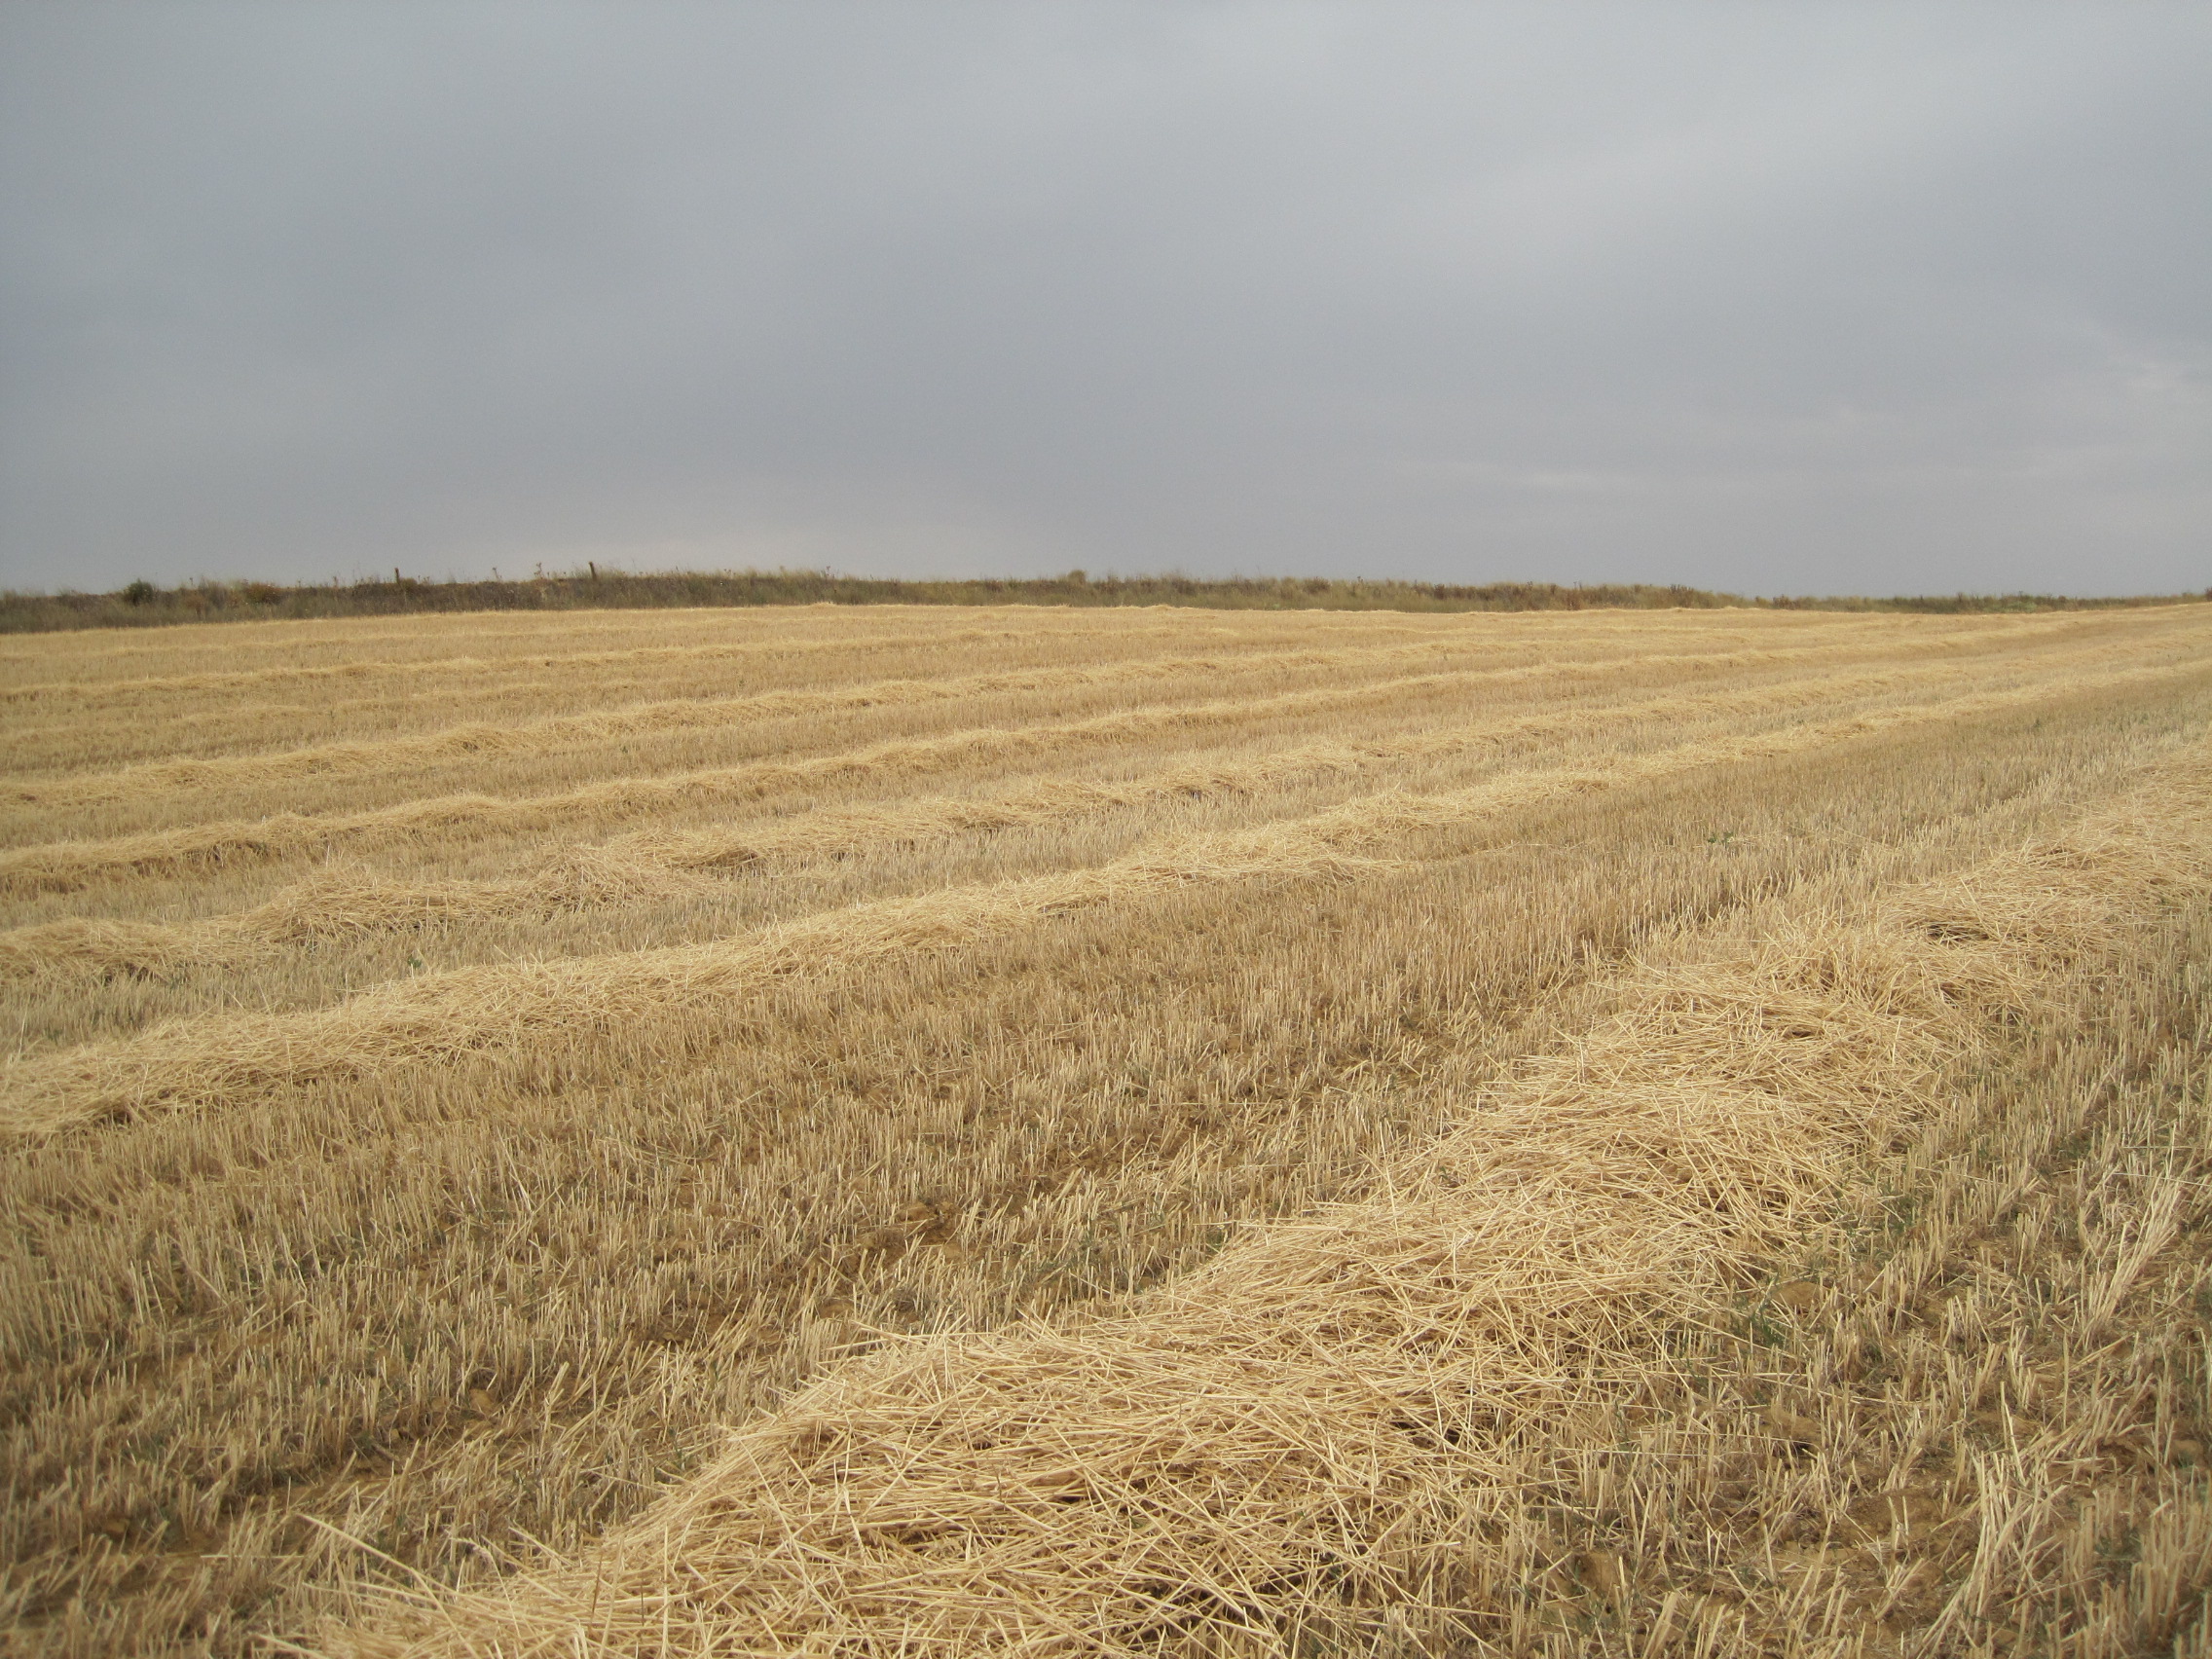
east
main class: Cropland
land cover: Common wheat
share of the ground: < 10 %
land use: Agriculture (excluding fallow land and kitchen gardens)
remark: Harvested field
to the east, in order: Common wheat; Grass margins; Other bare soil
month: July
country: ES
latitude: 41.8324
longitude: -5.5356
